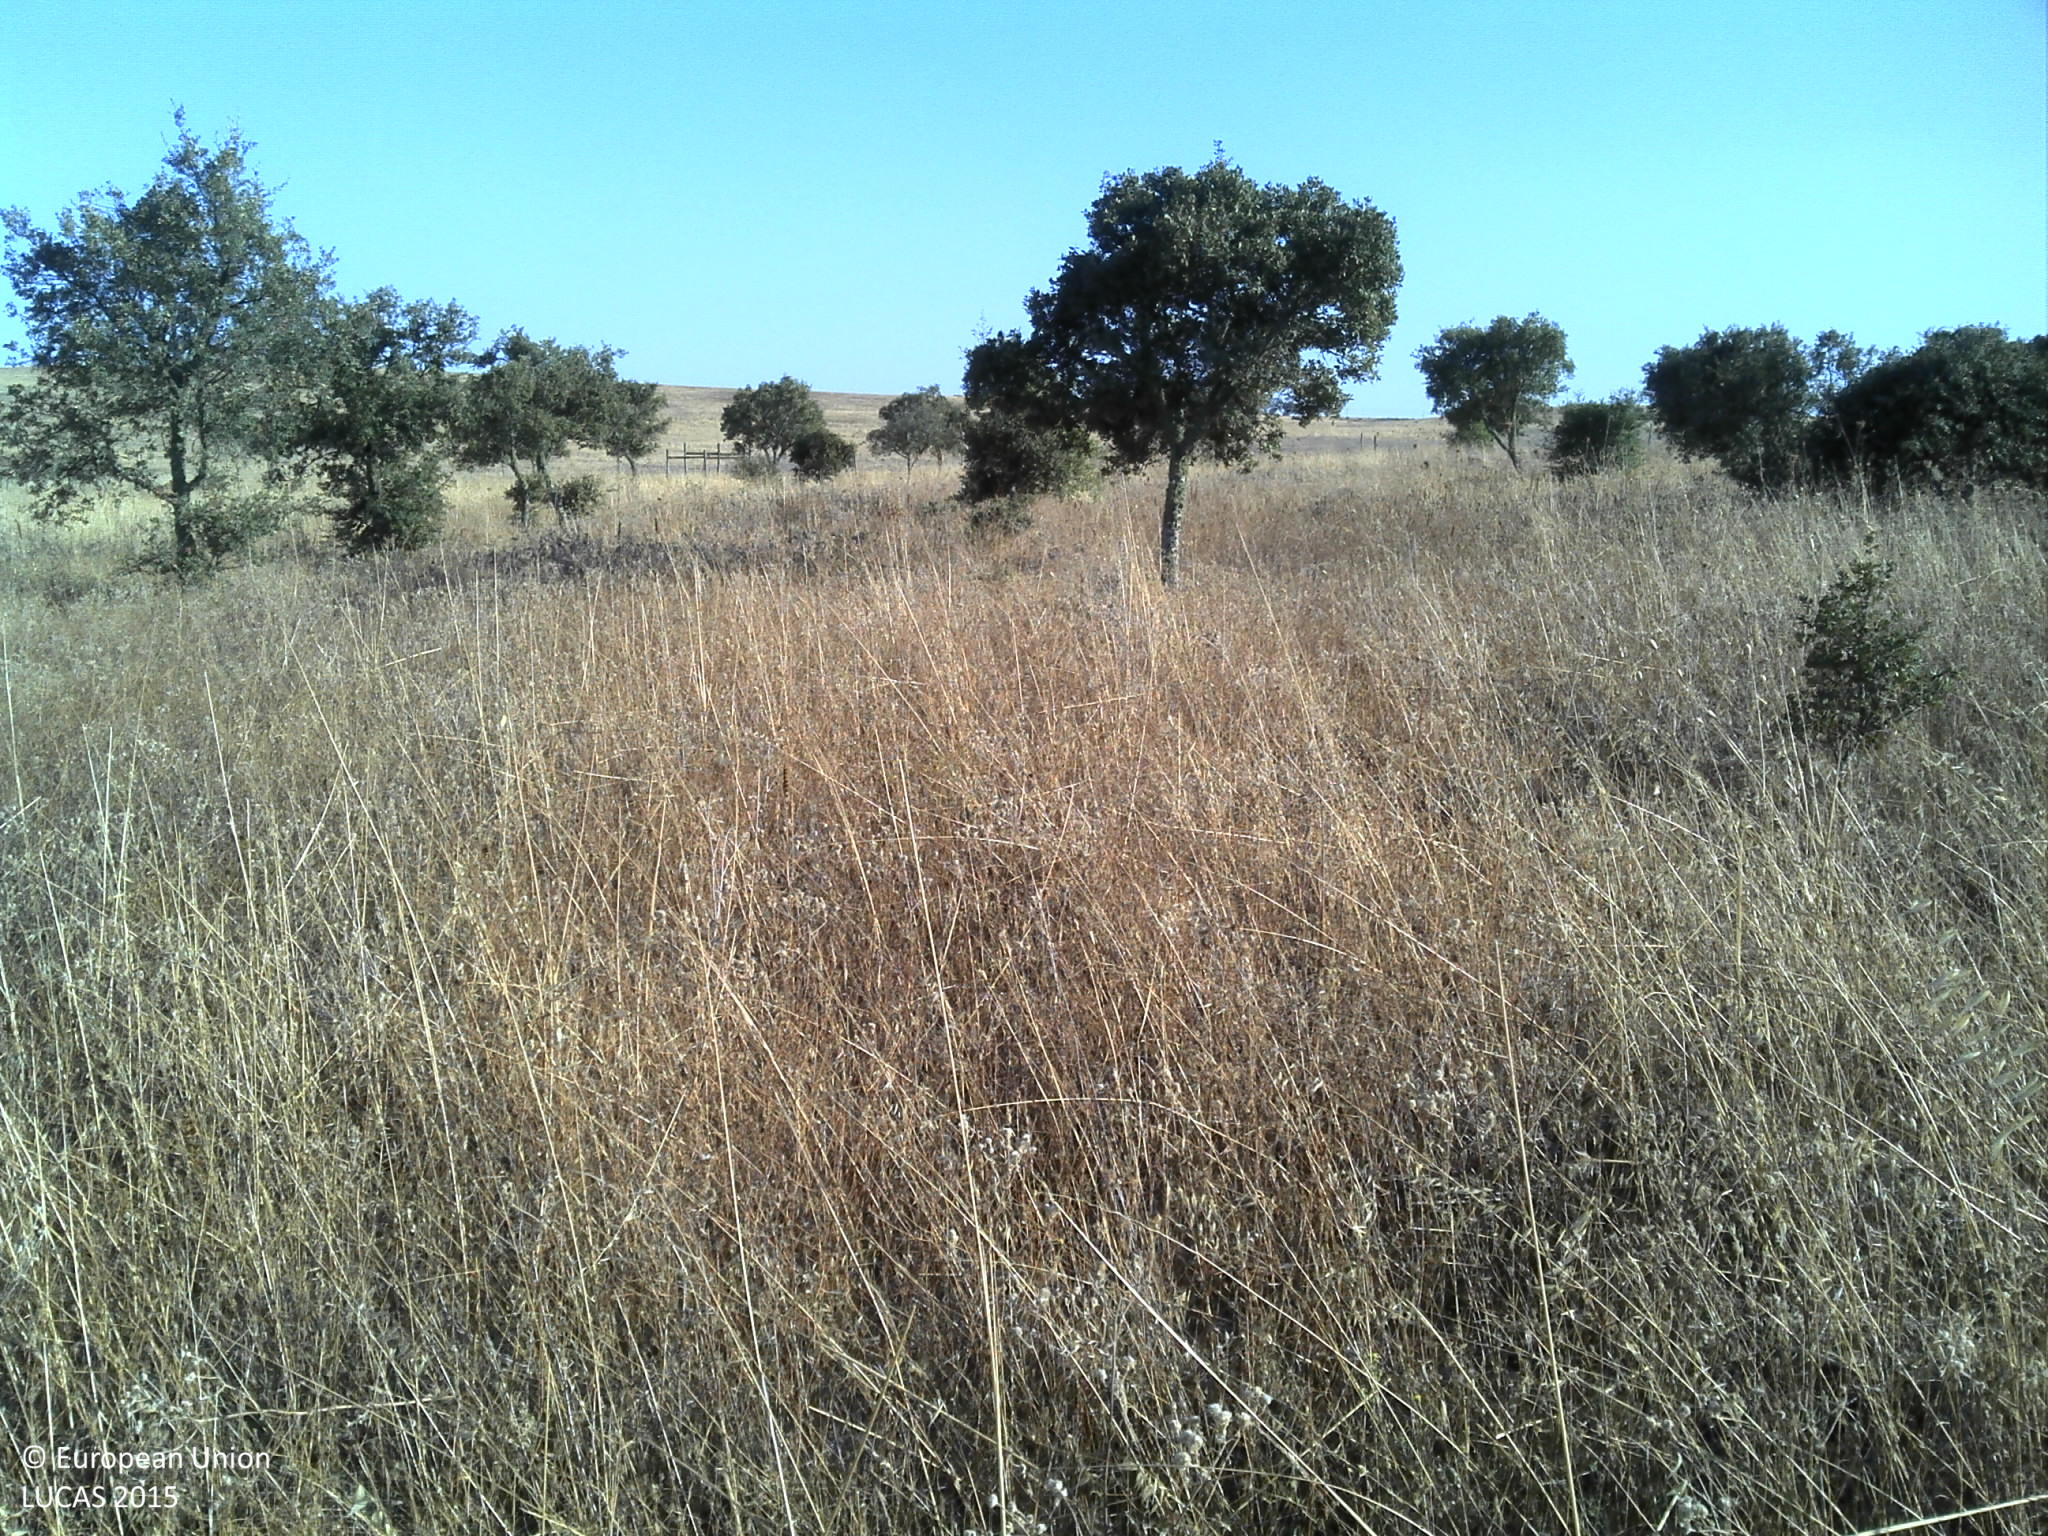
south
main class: Woodland
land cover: Broadleaved woodland
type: broadleaved evergreen forest
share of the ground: 25 - 50 %
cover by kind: broadleaved forest trees 75 %, herbaceous plants 15 %, unconsolidated bare surface 10 %
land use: Forestry
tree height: < 5 m
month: July
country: PT
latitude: 37.7075
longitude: -7.9570
